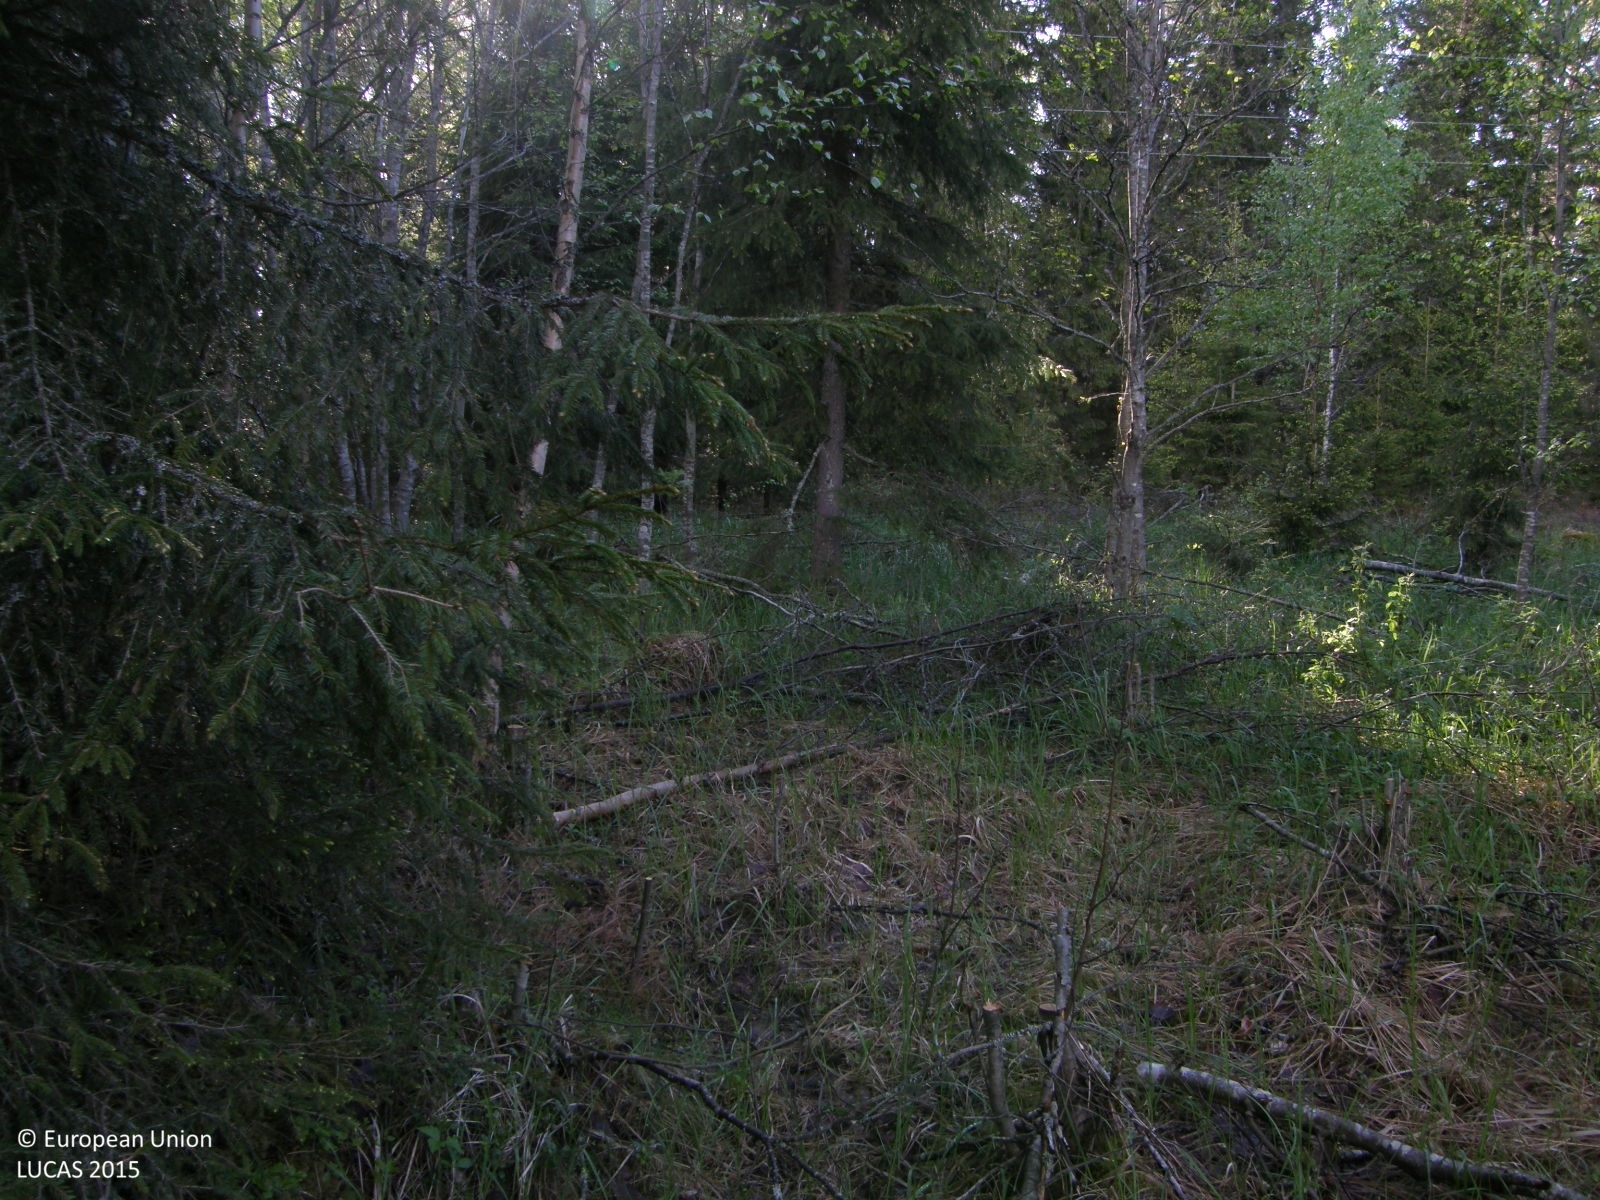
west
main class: Woodland
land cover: Spruce dominated mixed woodland
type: boreal forest
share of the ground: > 75 %
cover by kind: coniferous forest trees 50 %, broadleaved forest trees 25 %, herbaceous plants 25 %
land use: Forestry
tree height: > 5 m
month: June
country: FI
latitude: 62.0071
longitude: 21.7185
